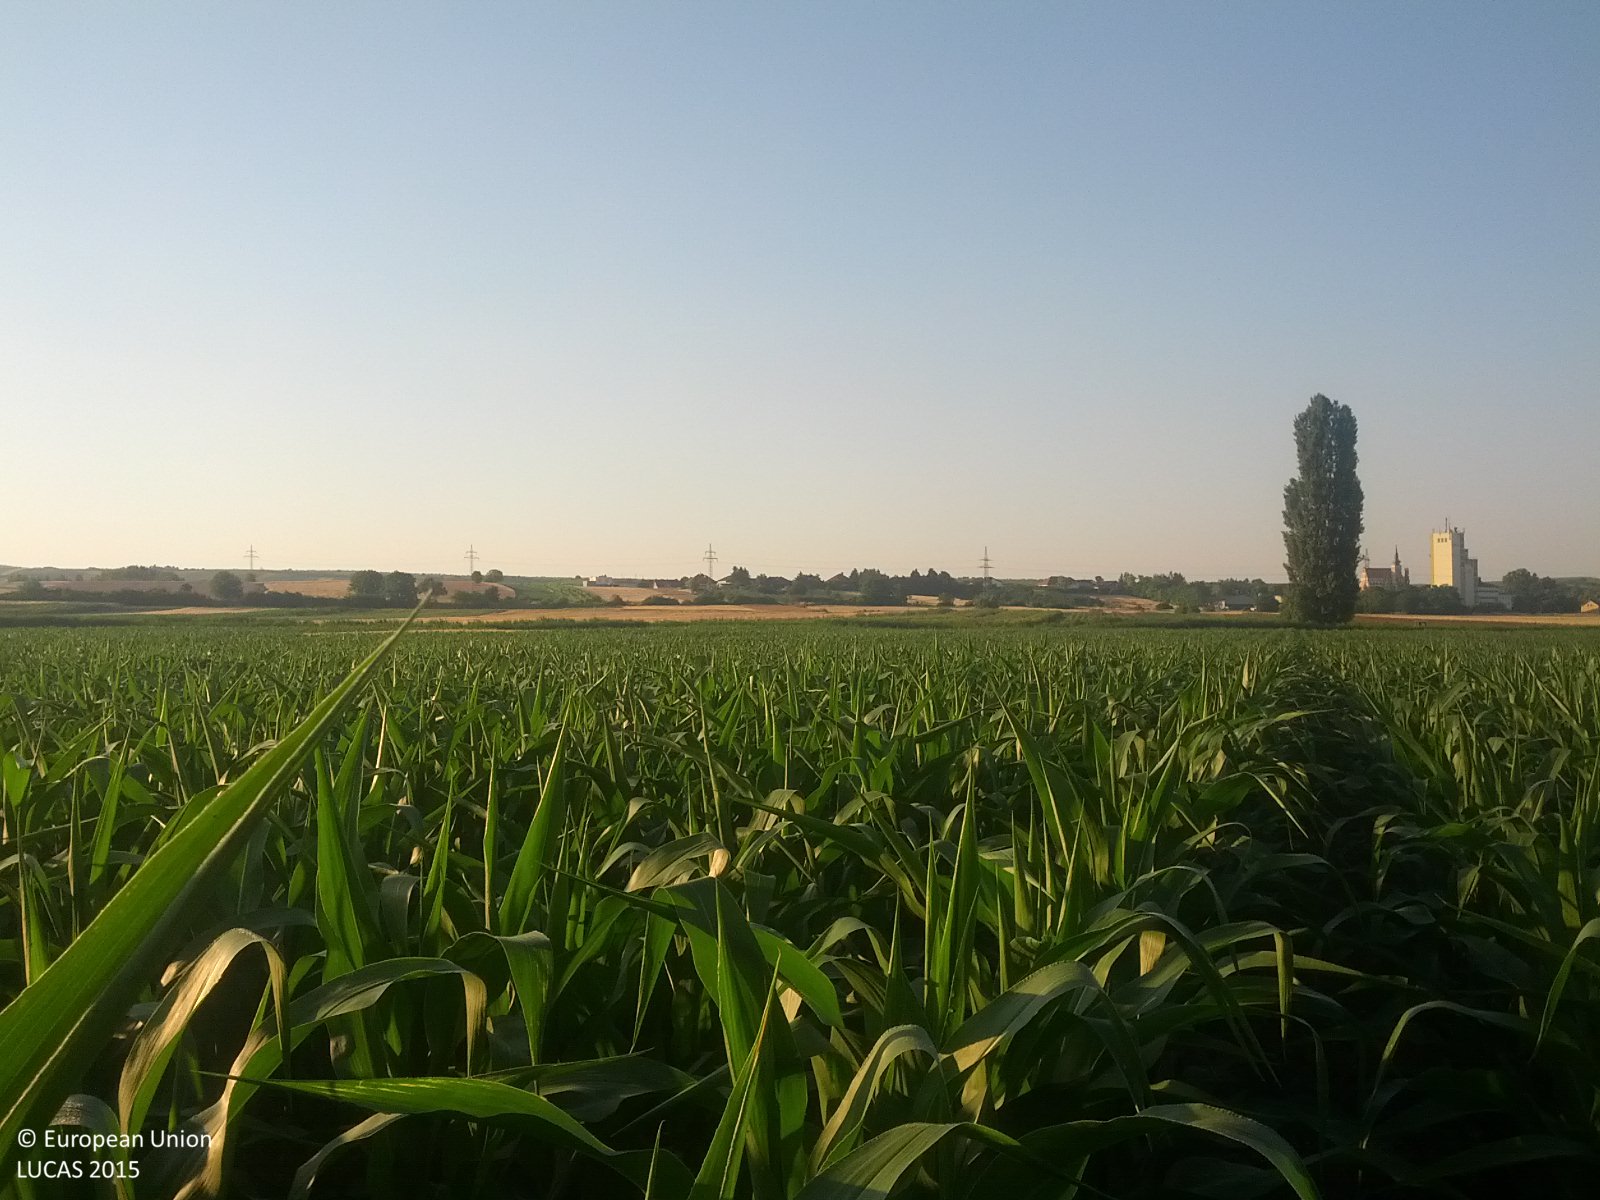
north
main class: Cropland
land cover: Maize
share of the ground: > 75 %
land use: Agriculture (excluding fallow land and kitchen gardens)
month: July
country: AT
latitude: 48.6565
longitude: 16.6180
